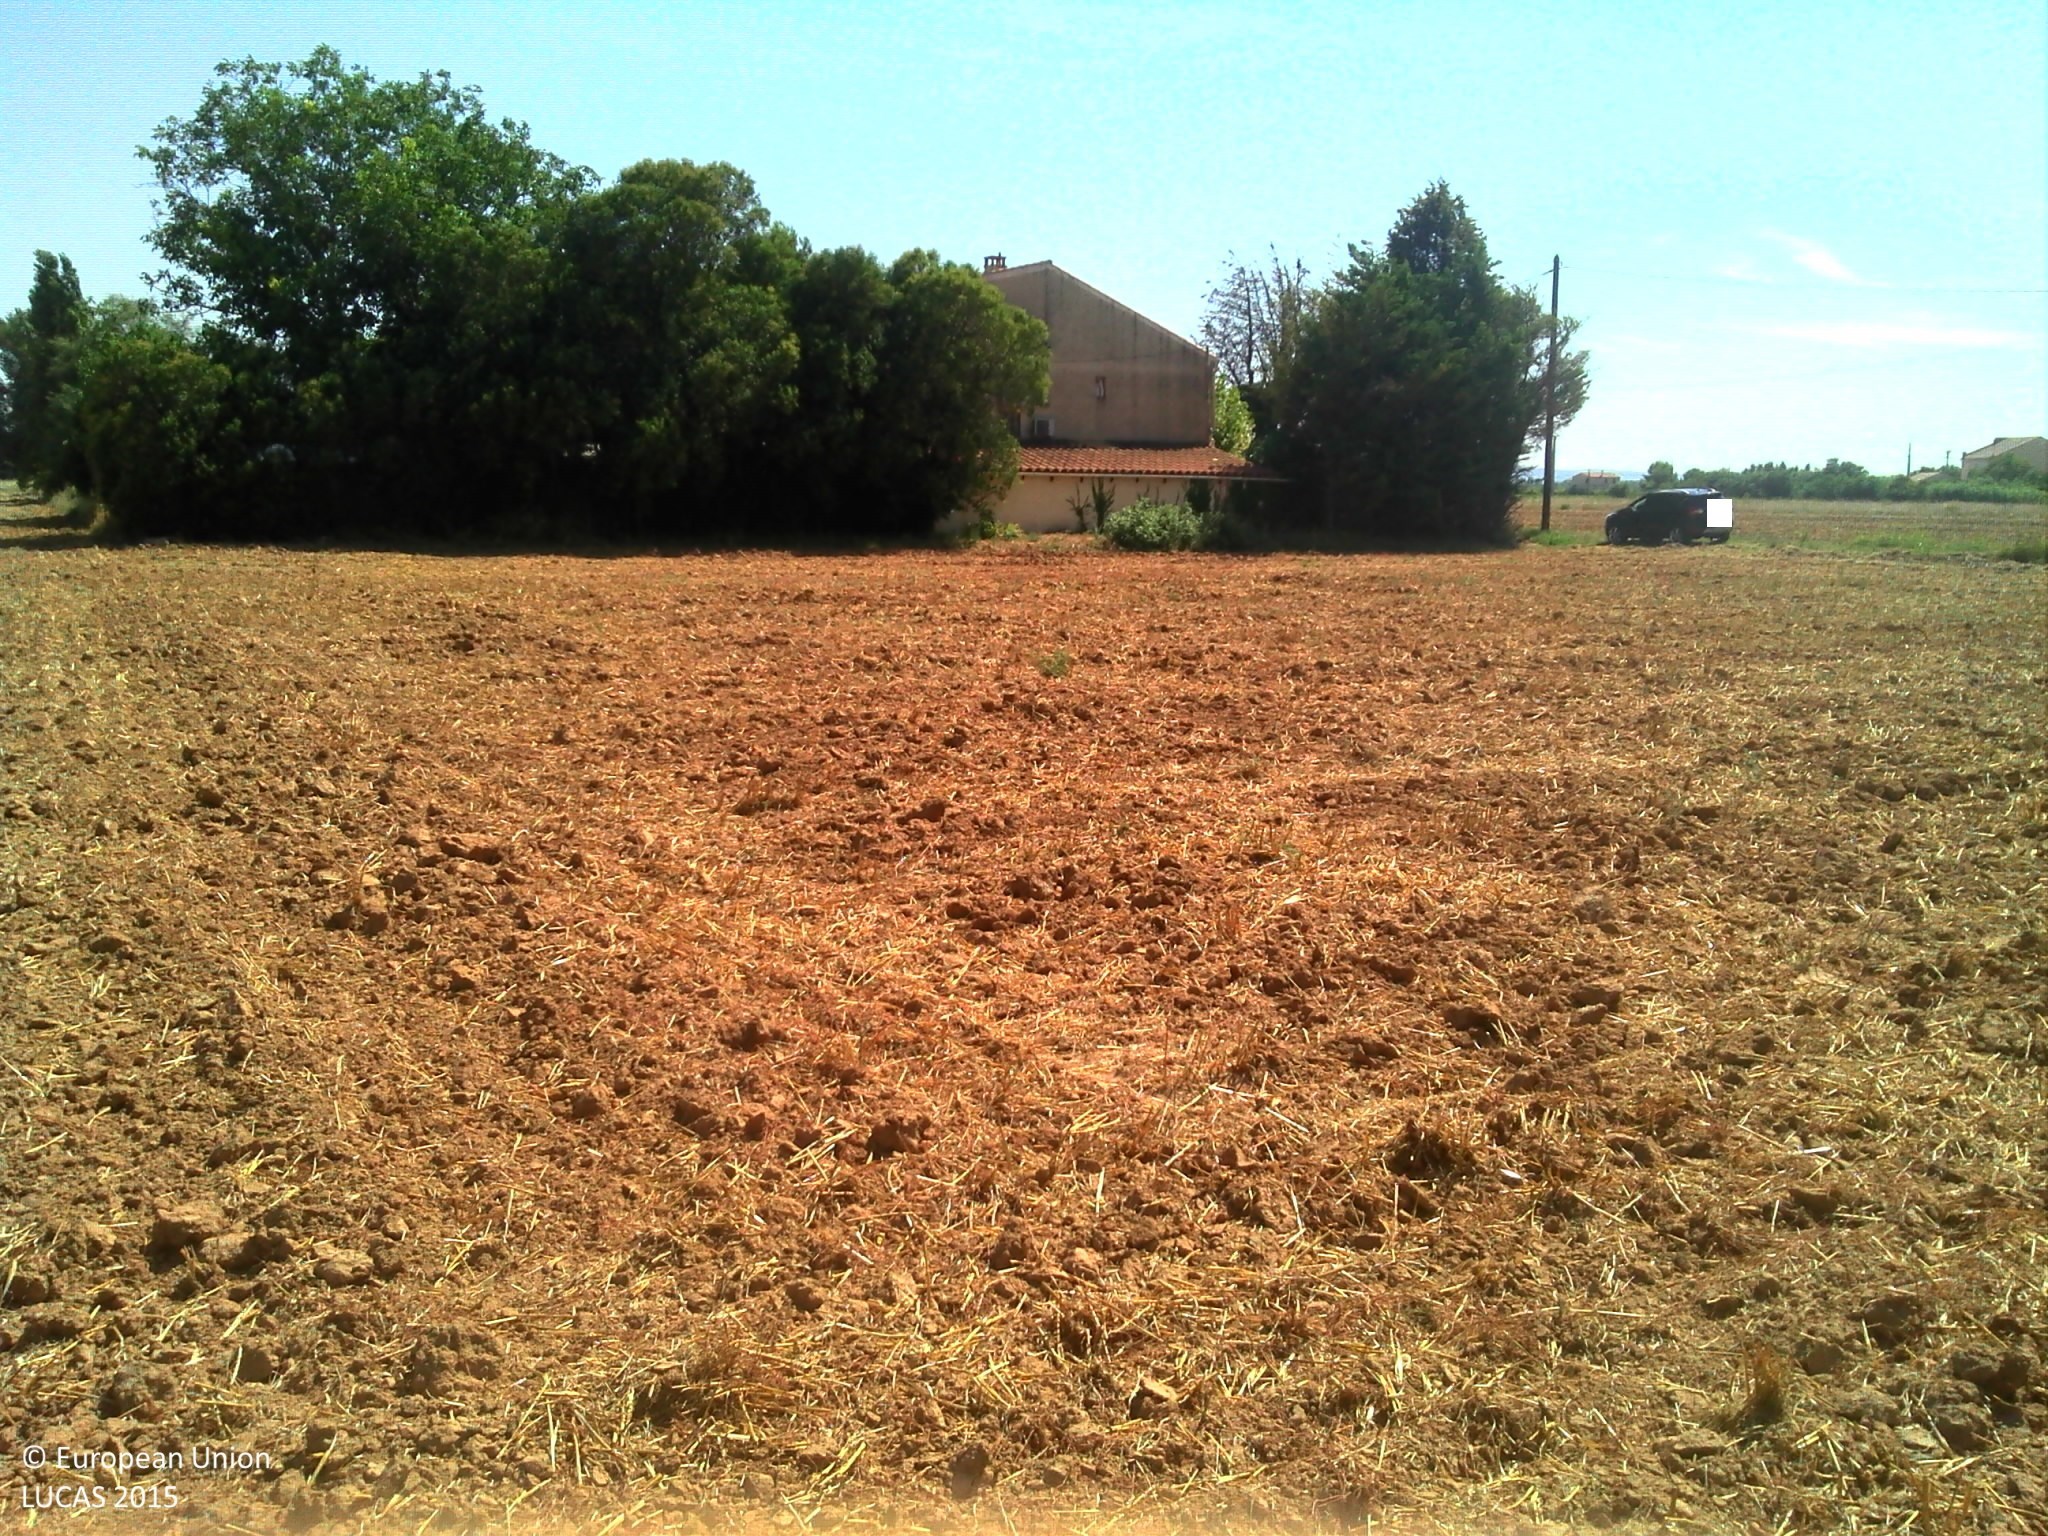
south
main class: Cropland
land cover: Durum wheat
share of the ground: < 10 %
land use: Agriculture (excluding fallow land and kitchen gardens)
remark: Harvested field
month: August
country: FR
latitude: 43.4963
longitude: 5.1498
